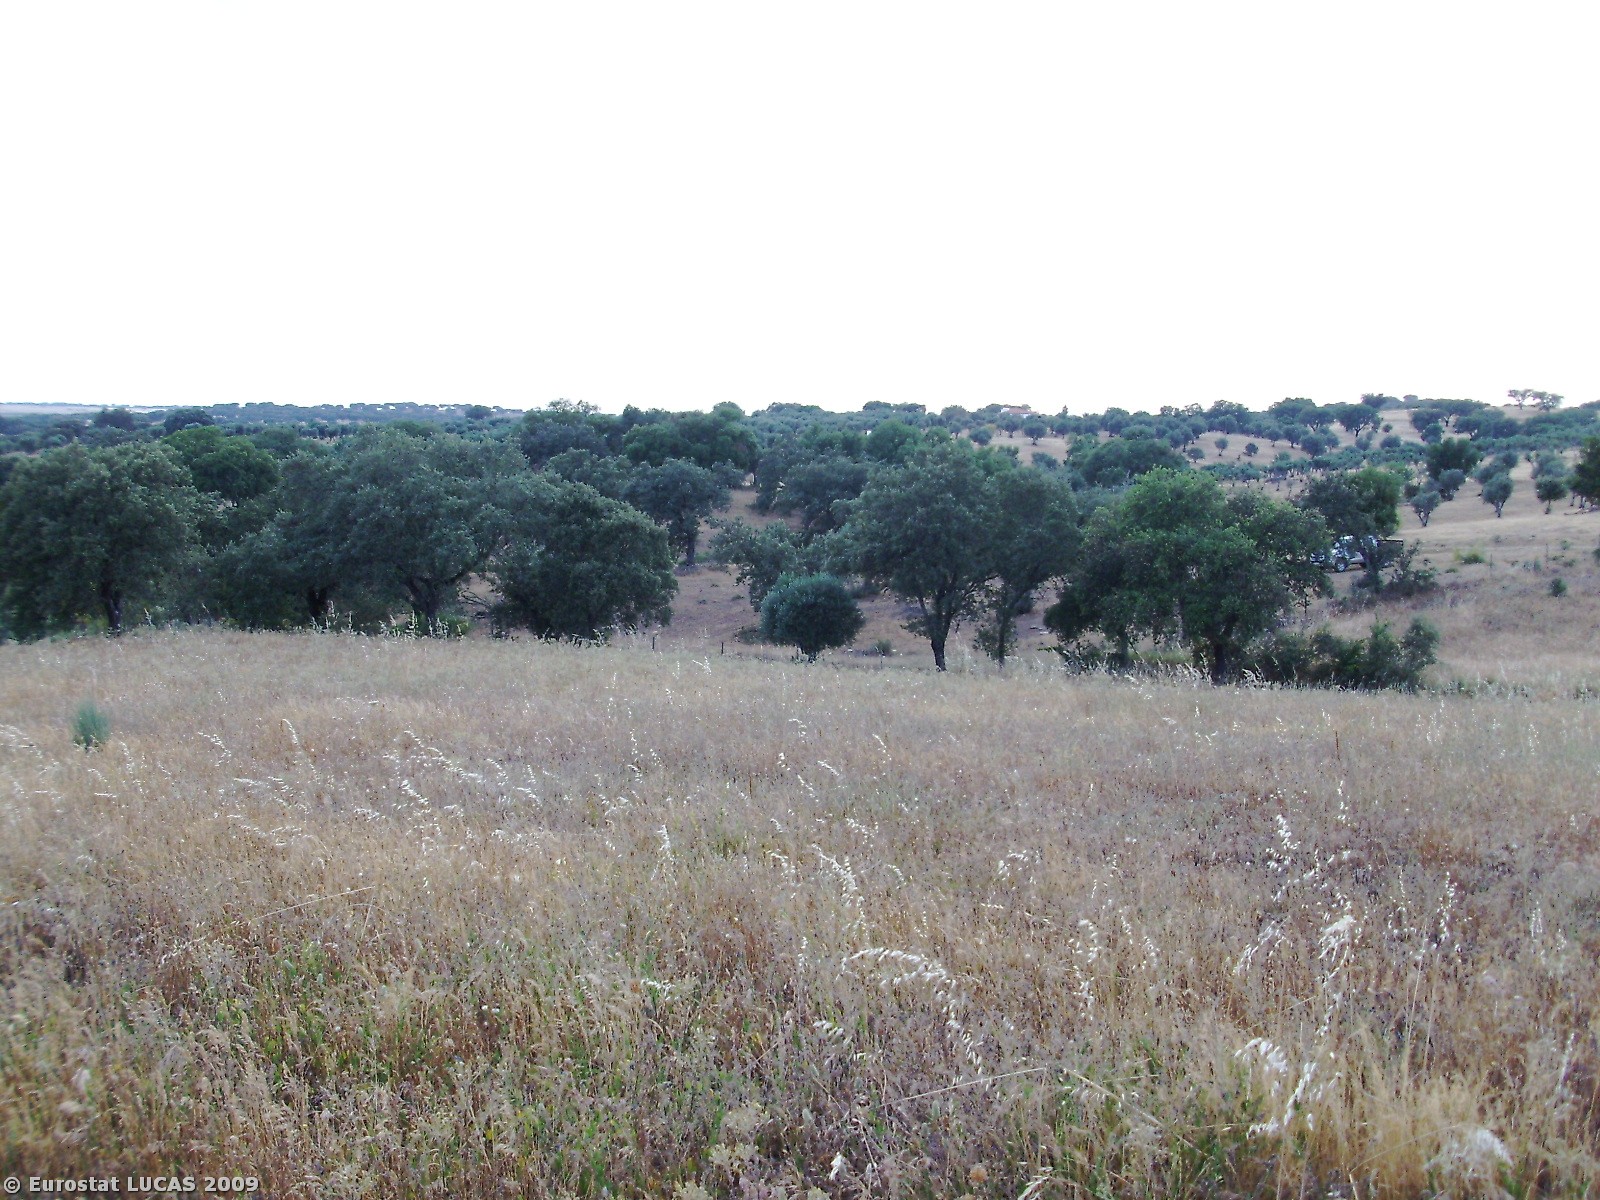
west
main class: Grassland
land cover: Spontaneously vegetated surfaces
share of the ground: > 75 %
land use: Fallow land
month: June
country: PT
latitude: 39.1401
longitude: -7.3092
